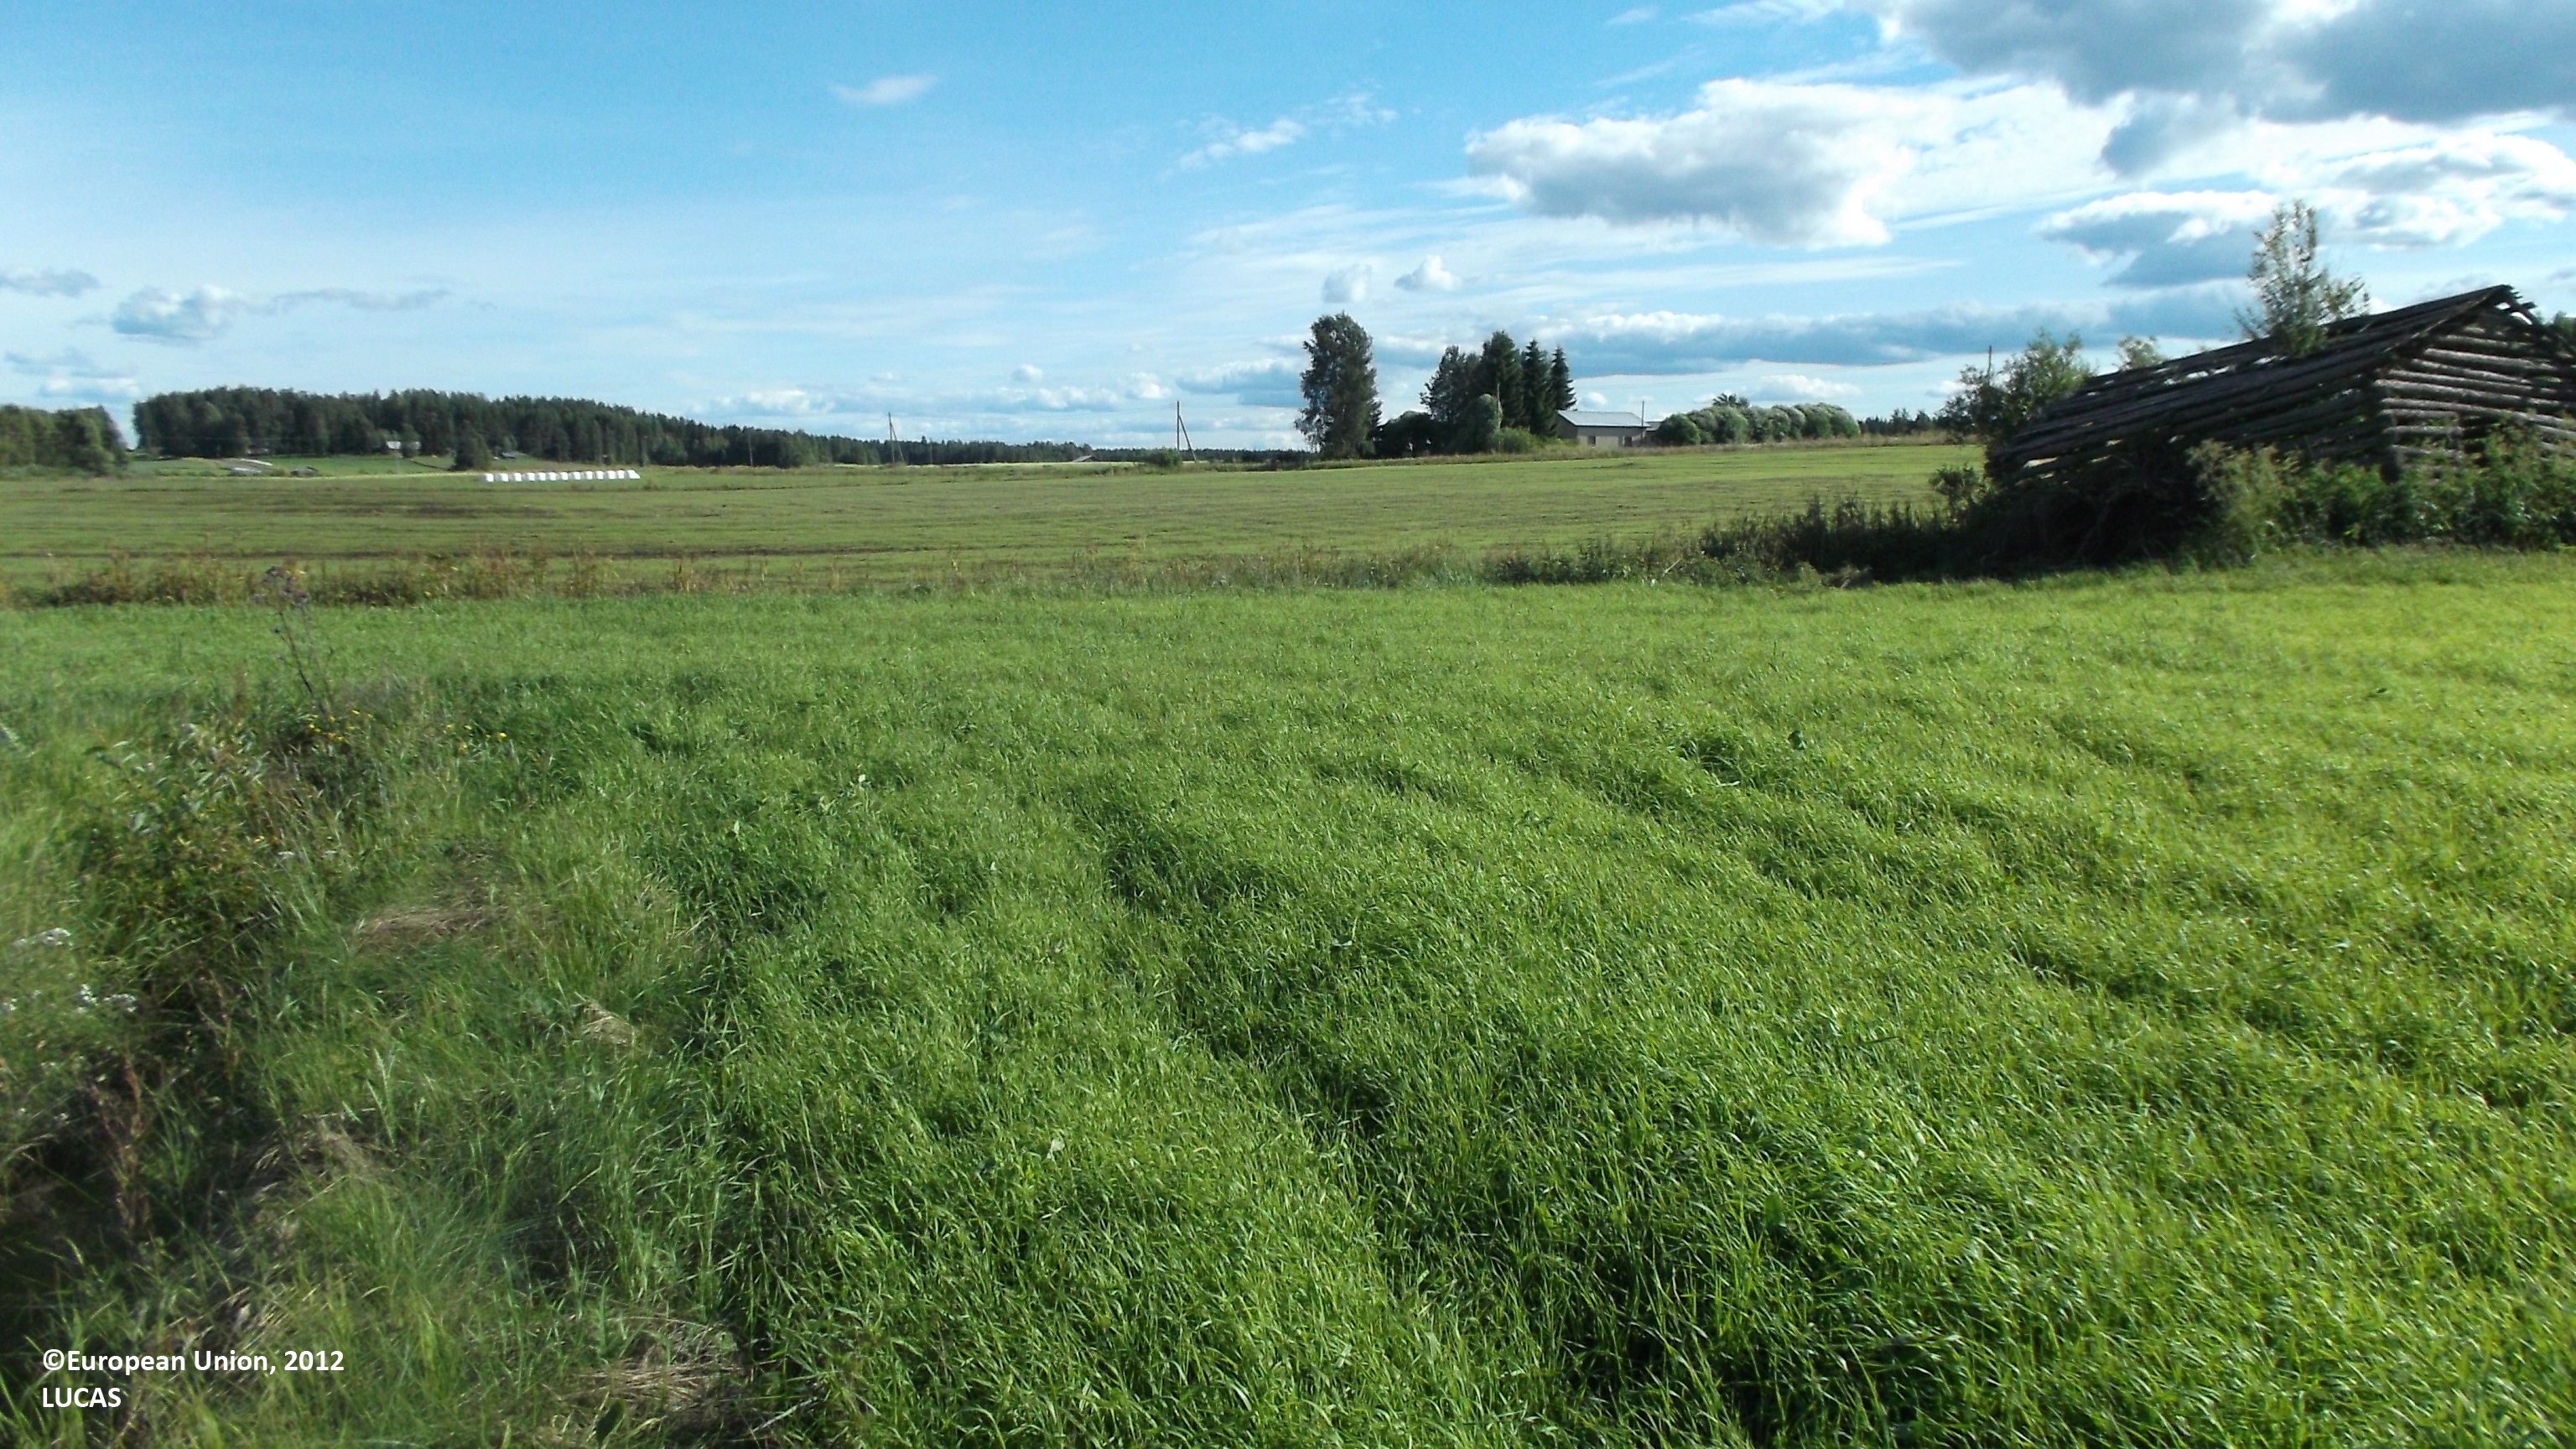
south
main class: Cropland
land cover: Temporary grasslands
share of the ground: > 75 %
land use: Agriculture (excluding fallow land and kitchen gardens)
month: July
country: FI
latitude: 63.2625
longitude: 23.7554
